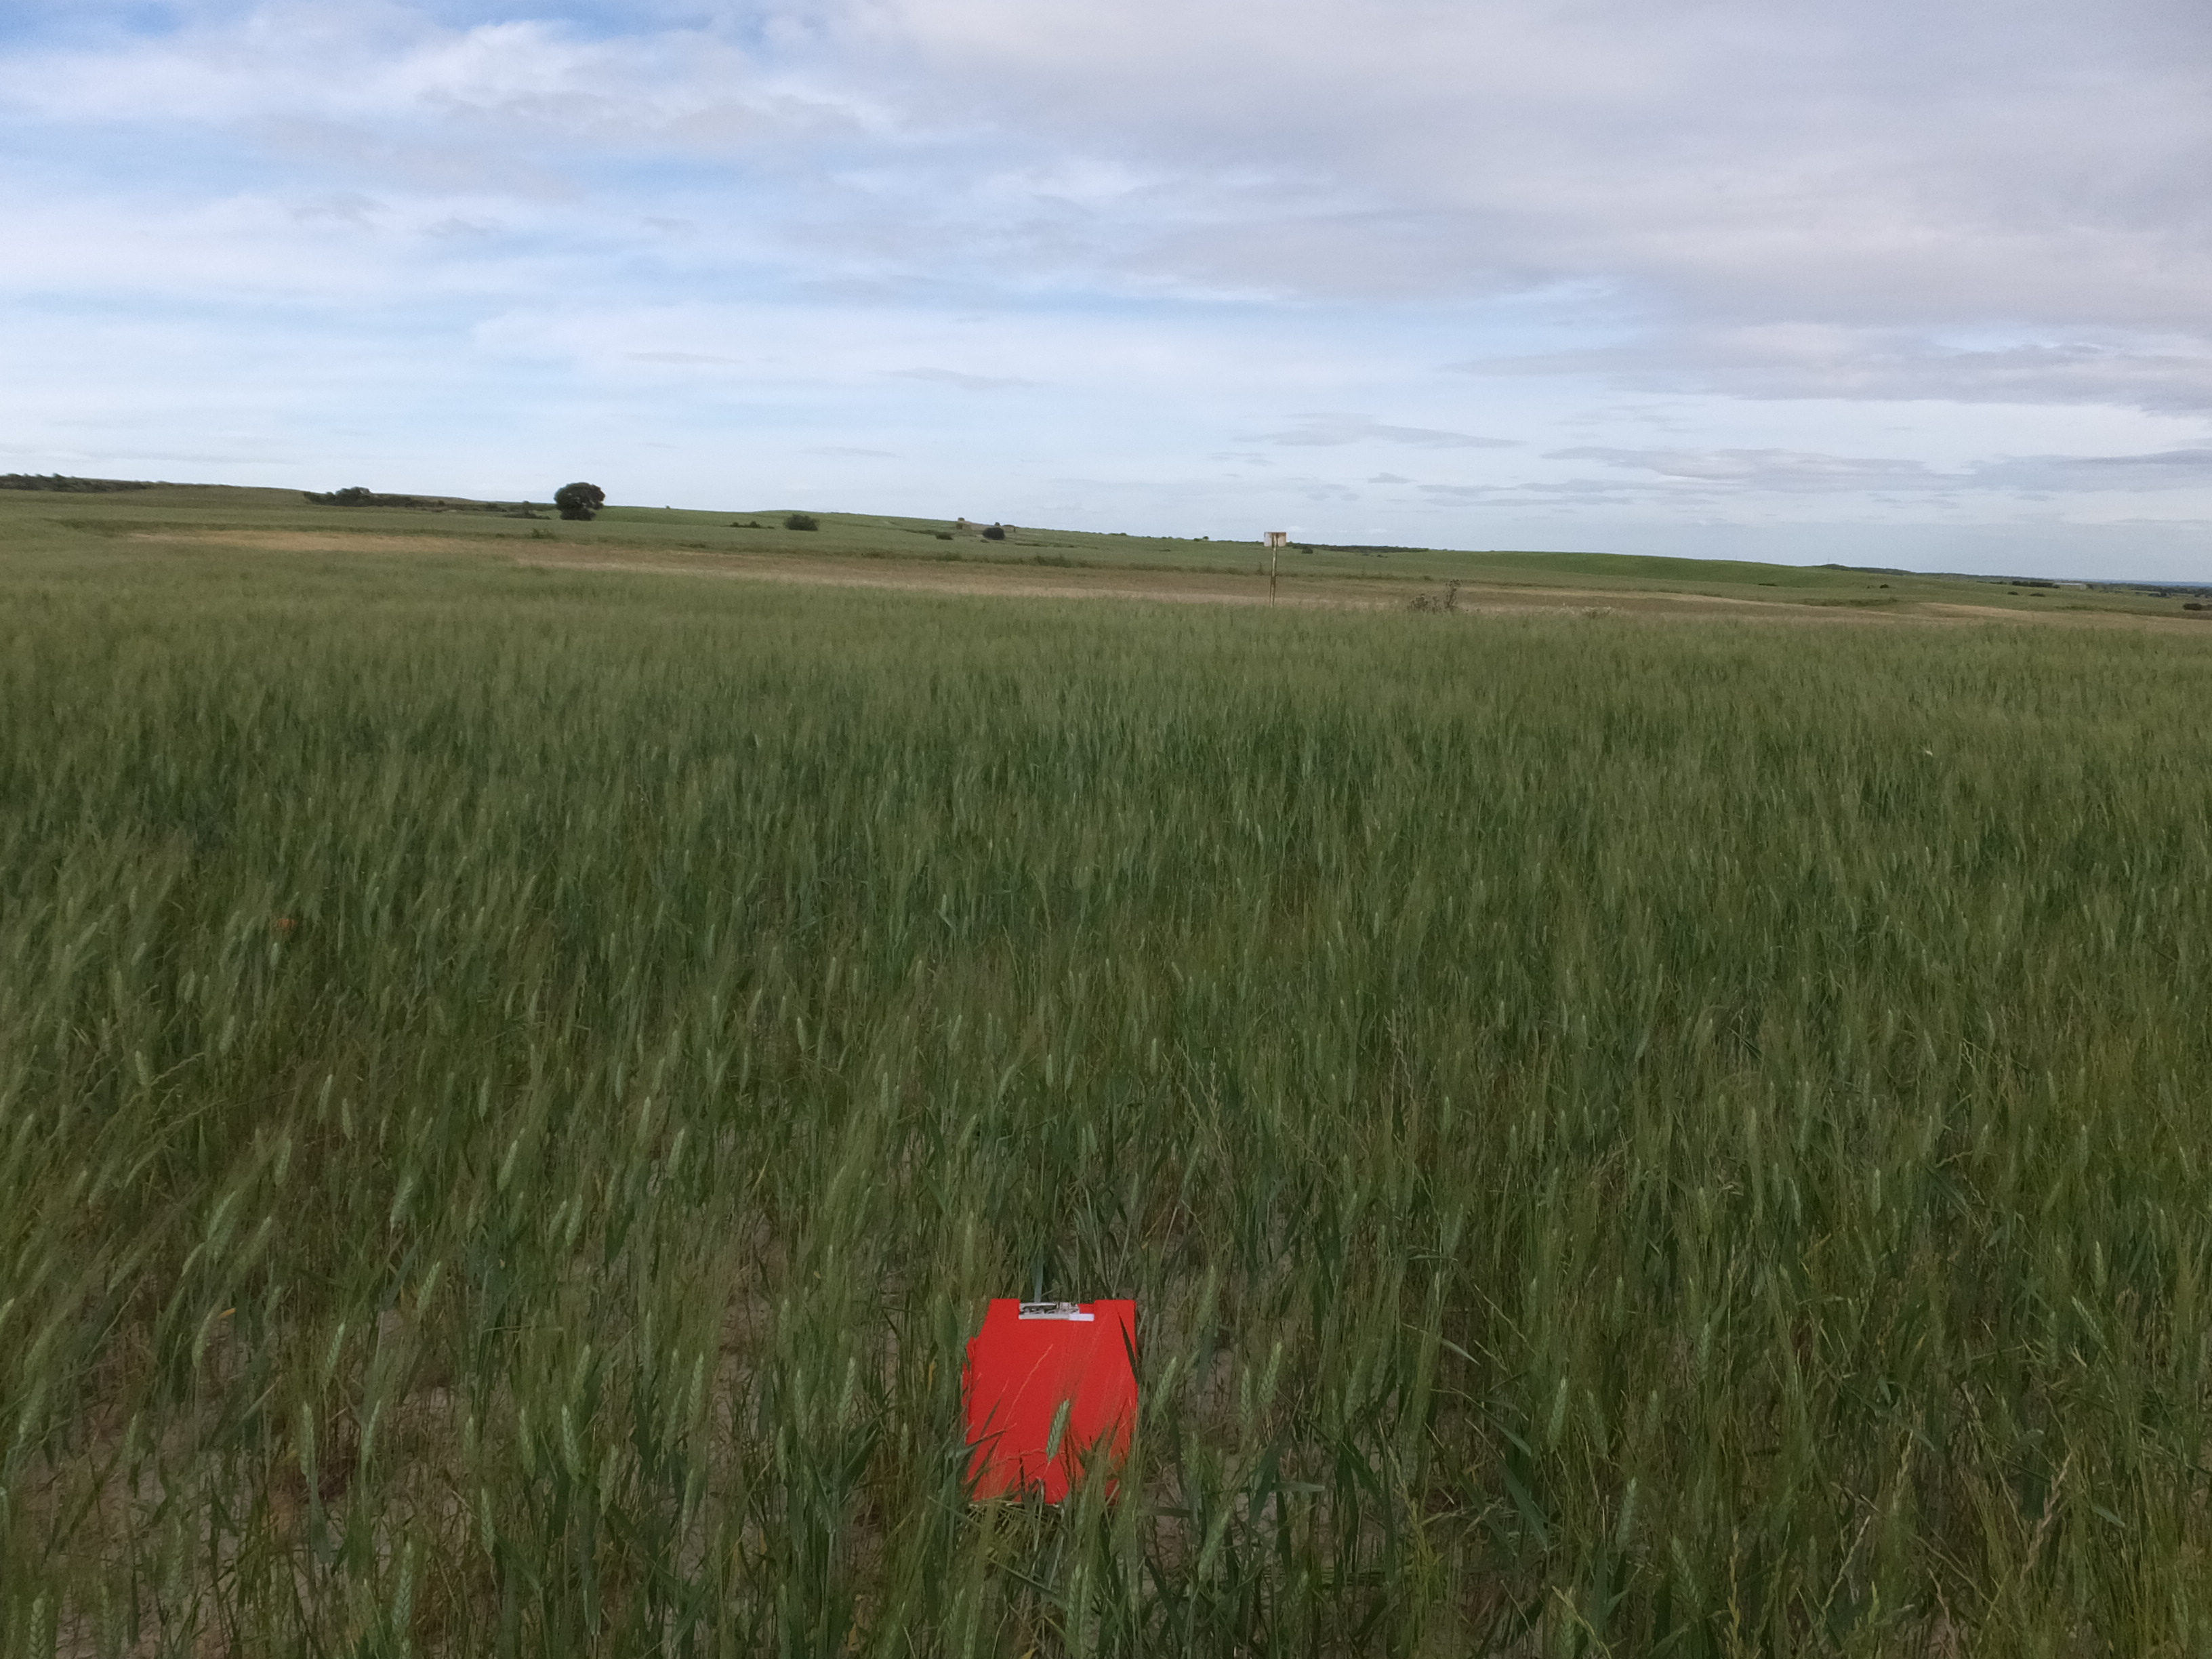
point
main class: Cropland
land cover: Durum wheat
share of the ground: > 75 %
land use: Agriculture (excluding fallow land and kitchen gardens)
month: May
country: ES
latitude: 41.6528
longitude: -0.1392
